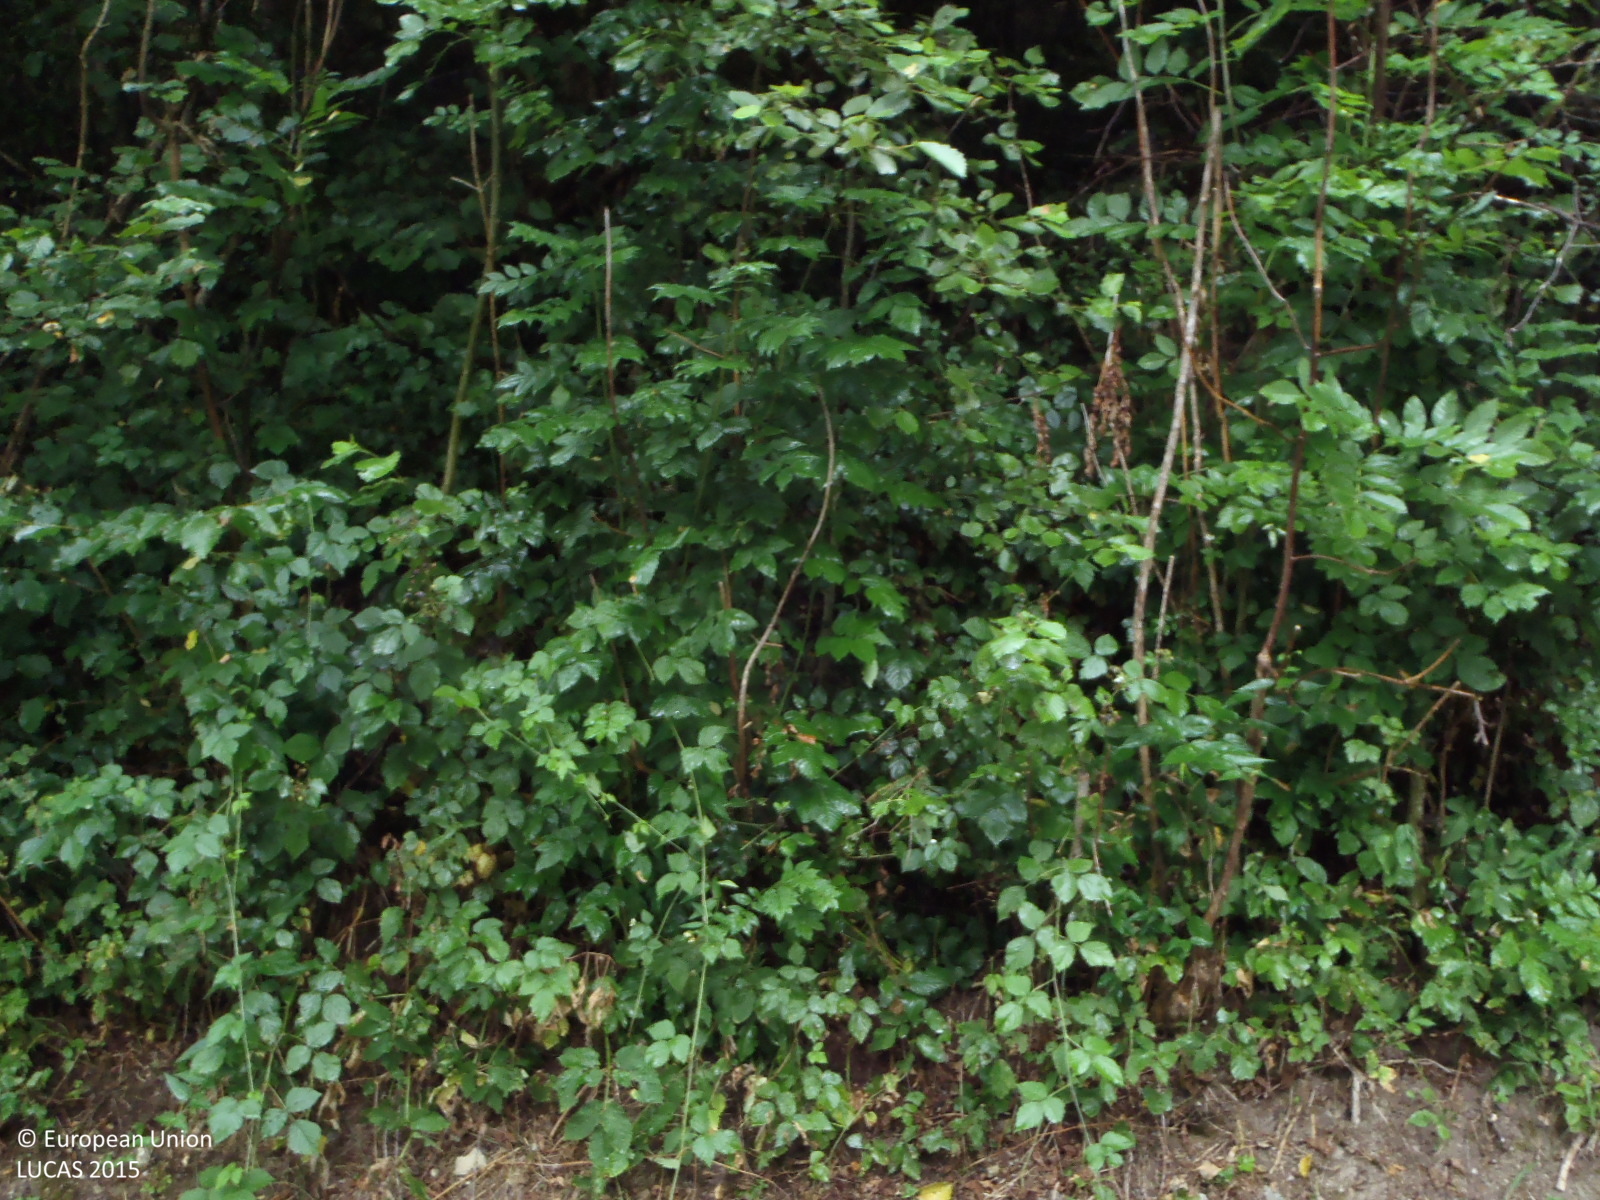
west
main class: Woodland
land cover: Spruce dominated mixed woodland
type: alpine coniferous forest
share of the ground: > 75 %
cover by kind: broadleaved forest trees 70 %, coniferous forest trees 30 %
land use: Forestry
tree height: > 5 m
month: July
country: AT
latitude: 47.1816
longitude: 11.8590
